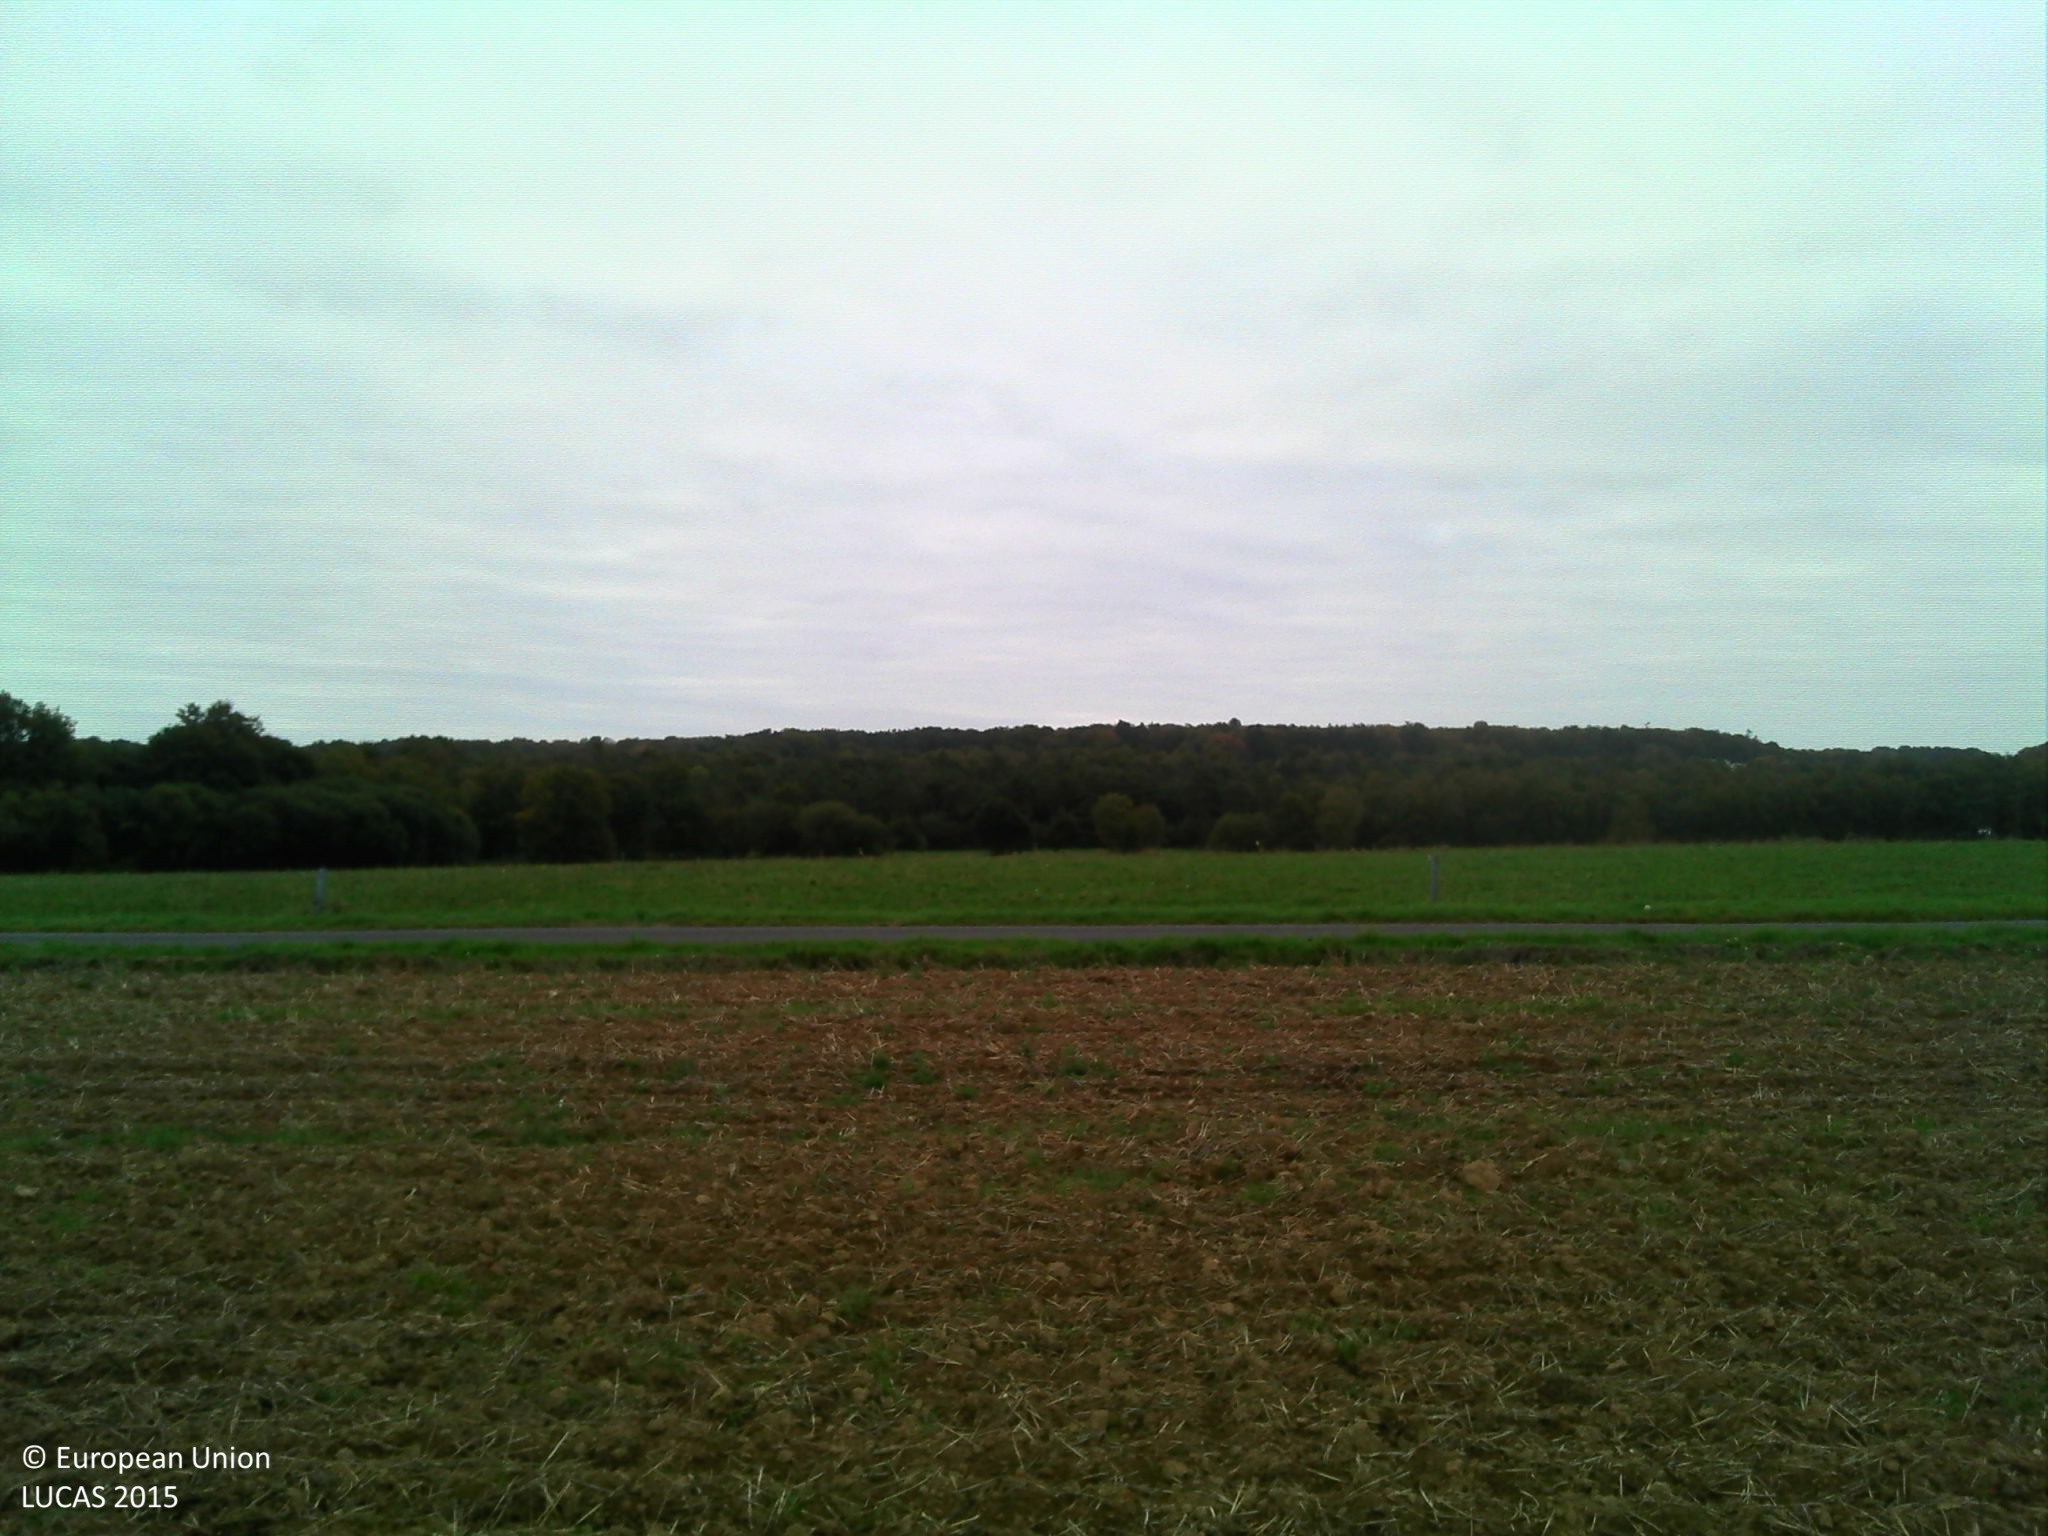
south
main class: Cropland
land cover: Common wheat
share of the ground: < 10 %
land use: Agriculture (excluding fallow land and kitchen gardens)
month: October
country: FR
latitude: 48.1382
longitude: -2.4087
